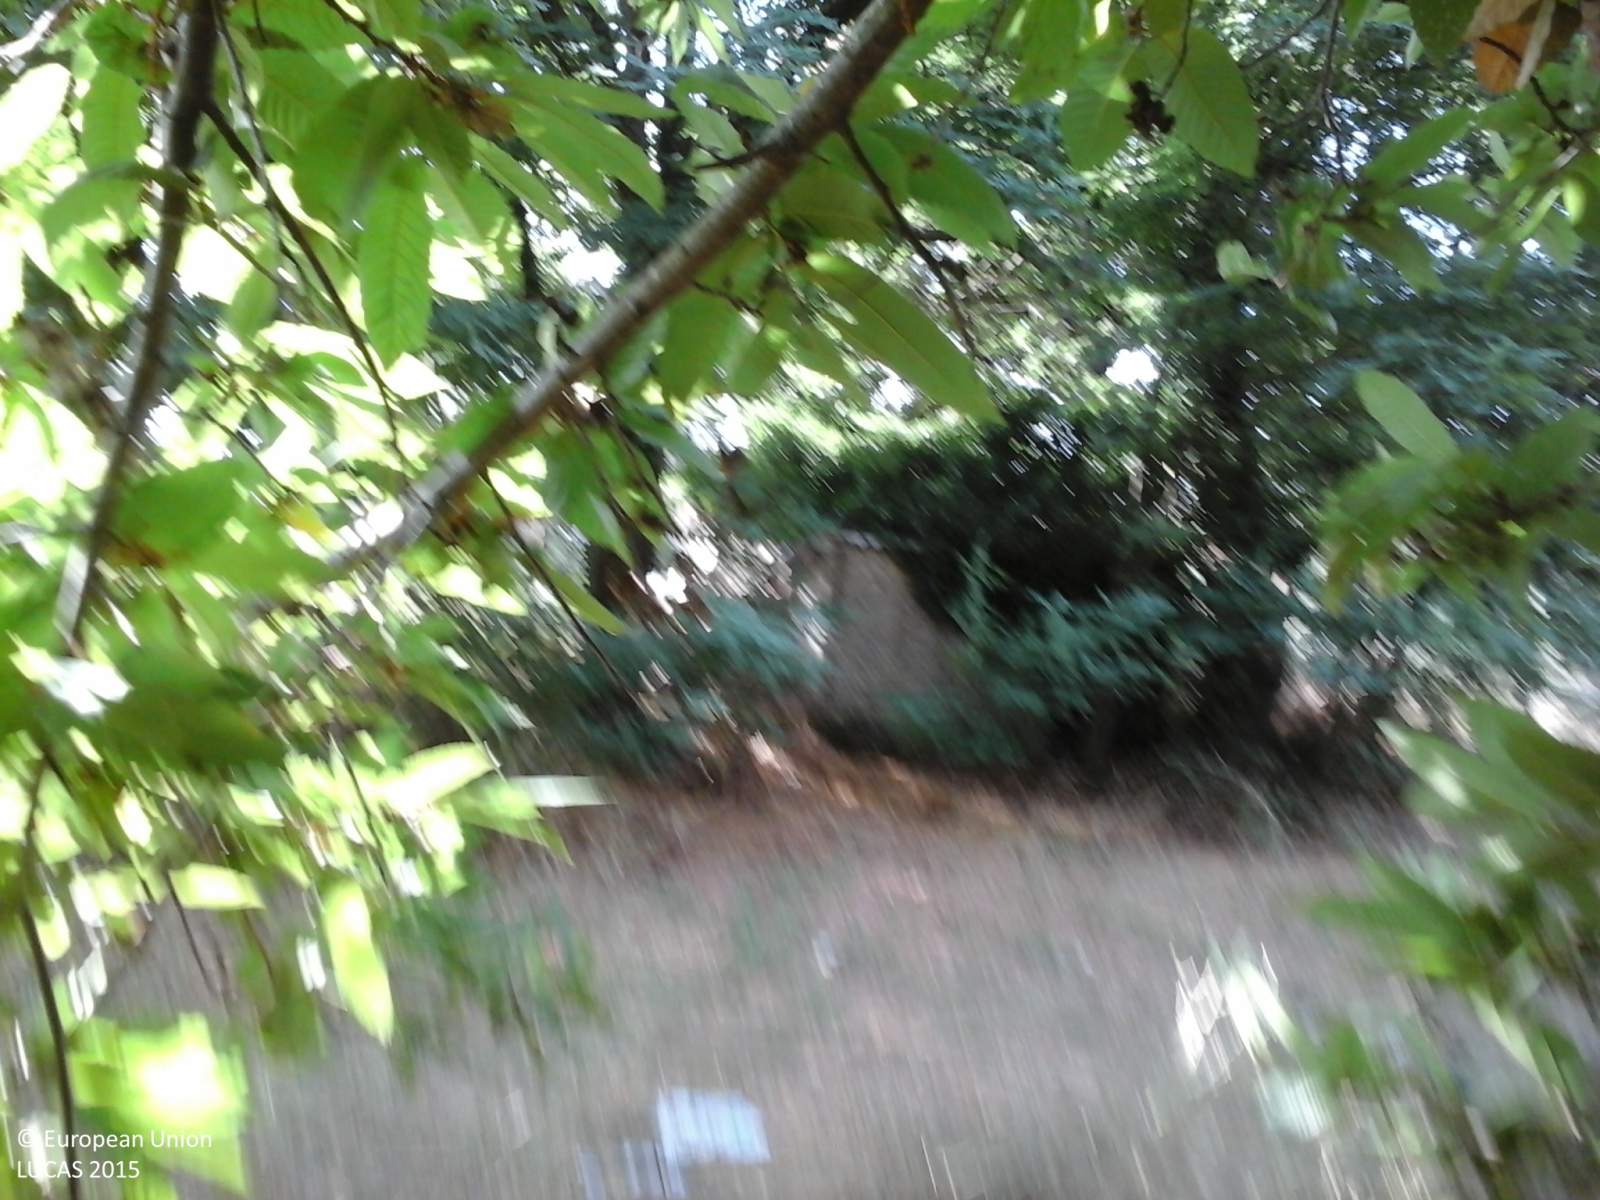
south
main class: Woodland
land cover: Broadleaved woodland
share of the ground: 50 - 75 %
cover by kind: broadleaved forest trees 60 %, shrubs 20 %, herbaceous plants 20 %
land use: Semi-natural and natural areas not in use
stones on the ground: < 10 %
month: August
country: IT
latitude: 42.6223
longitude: 11.6648
